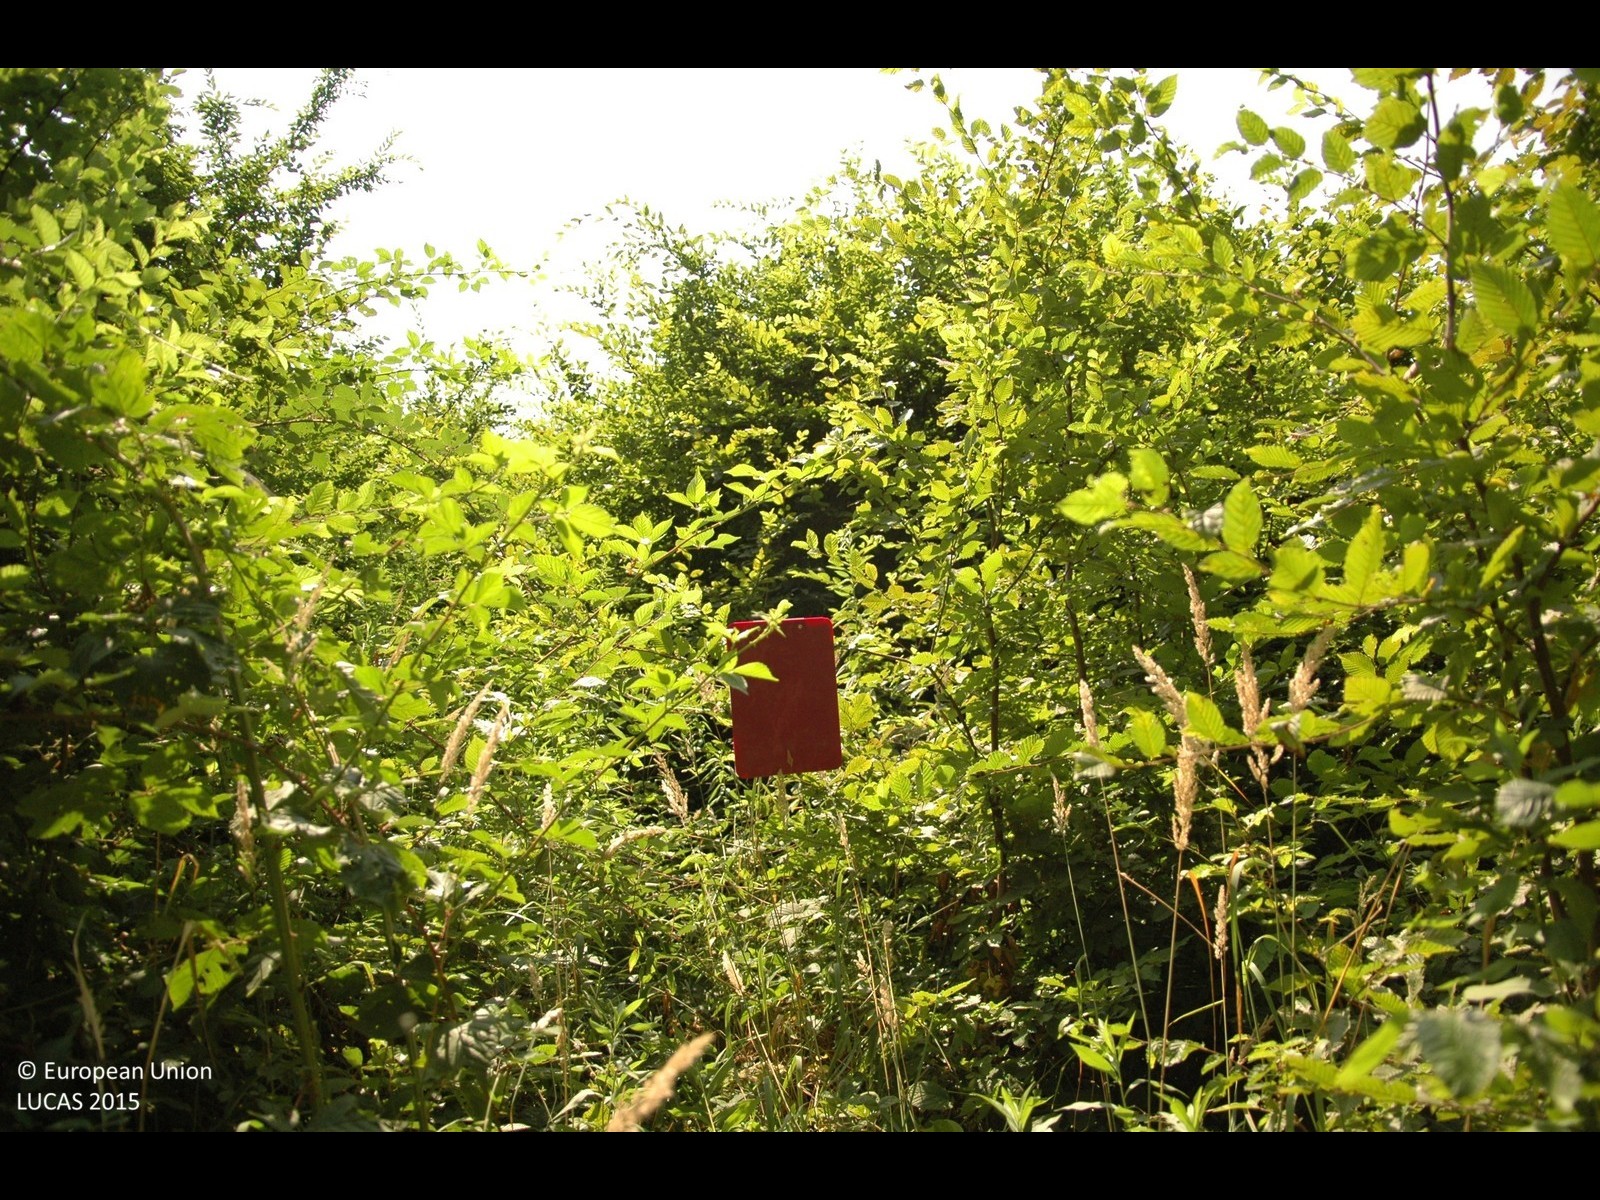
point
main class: Woodland
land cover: Broadleaved woodland
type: mesophytic deciduous forest
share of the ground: > 75 %
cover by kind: broadleaved forest trees 100 %
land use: Forestry
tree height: < 5 m
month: July
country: HR
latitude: 46.1642
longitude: 16.6184
